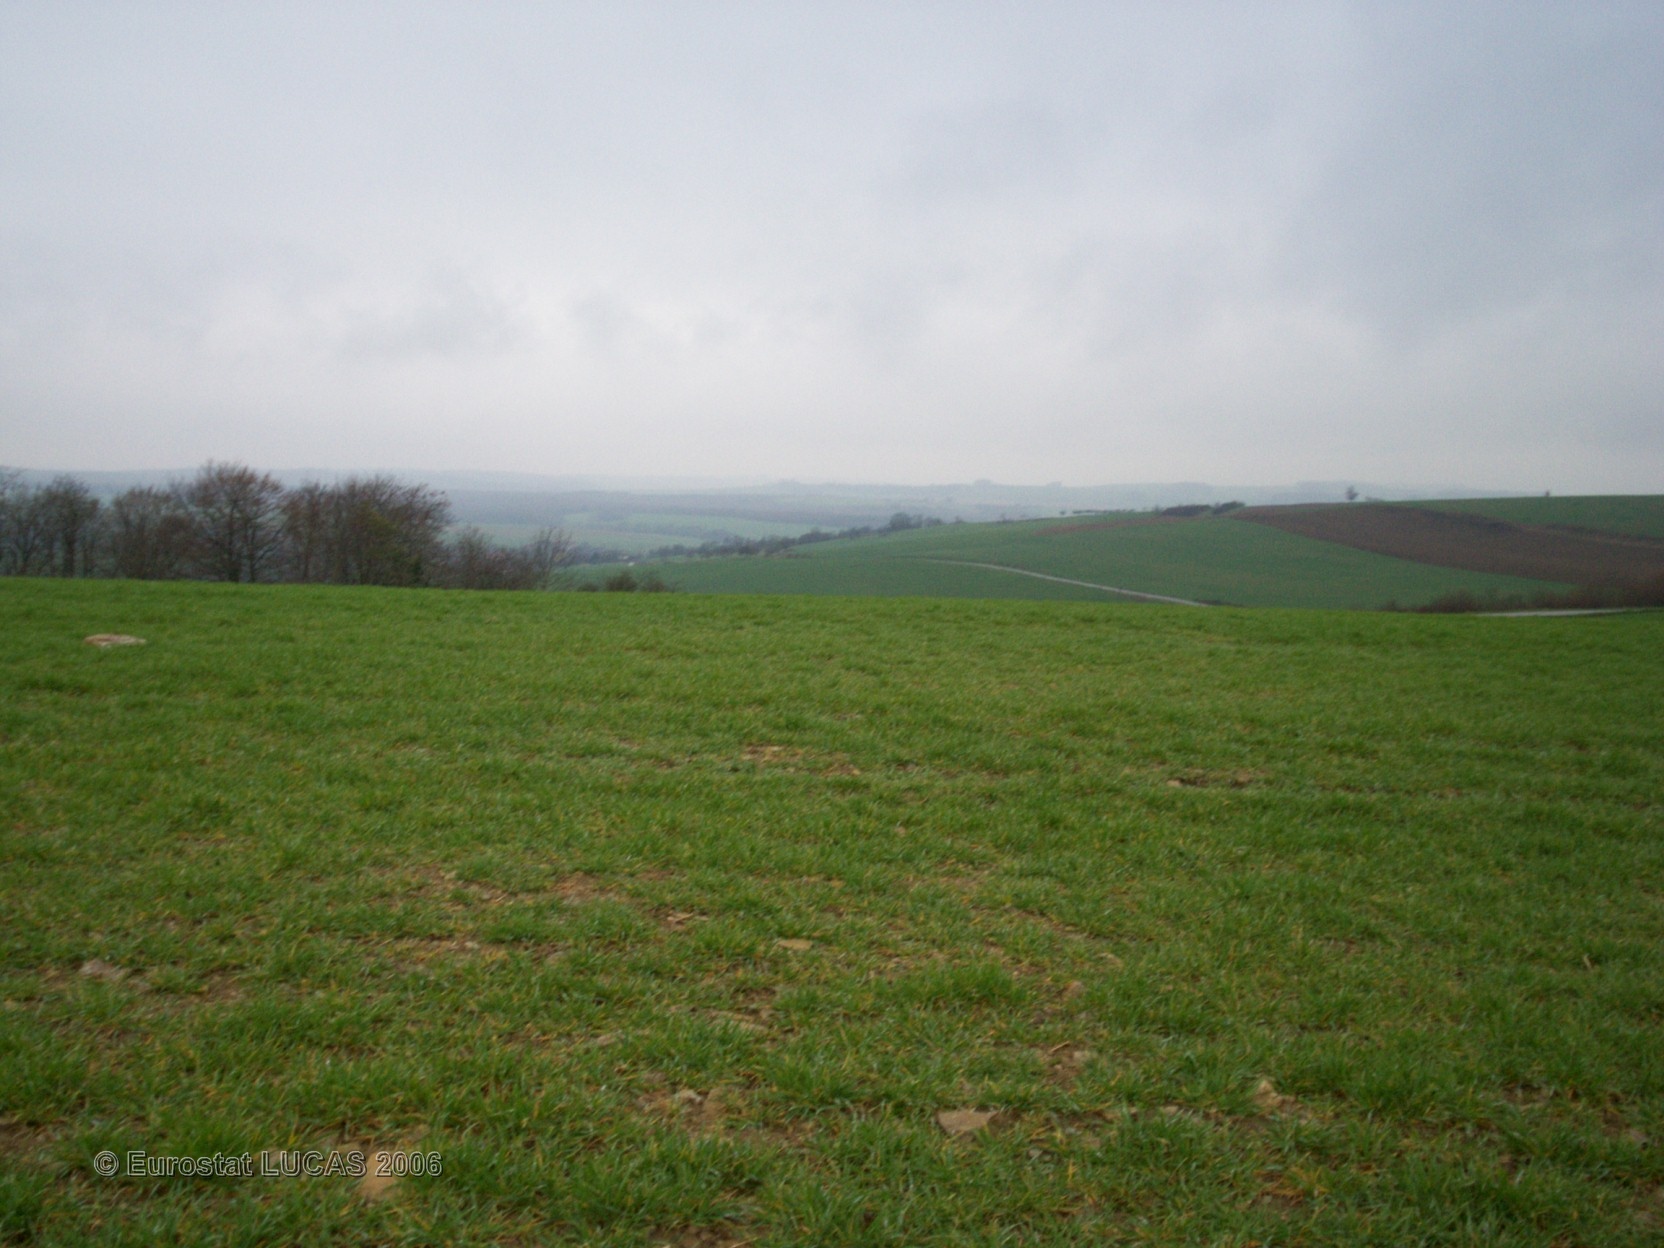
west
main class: Cropland
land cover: Barley
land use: Agriculture (excluding fallow land and kitchen gardens)
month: April
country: FR
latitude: 48.1598
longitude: 6.2497
